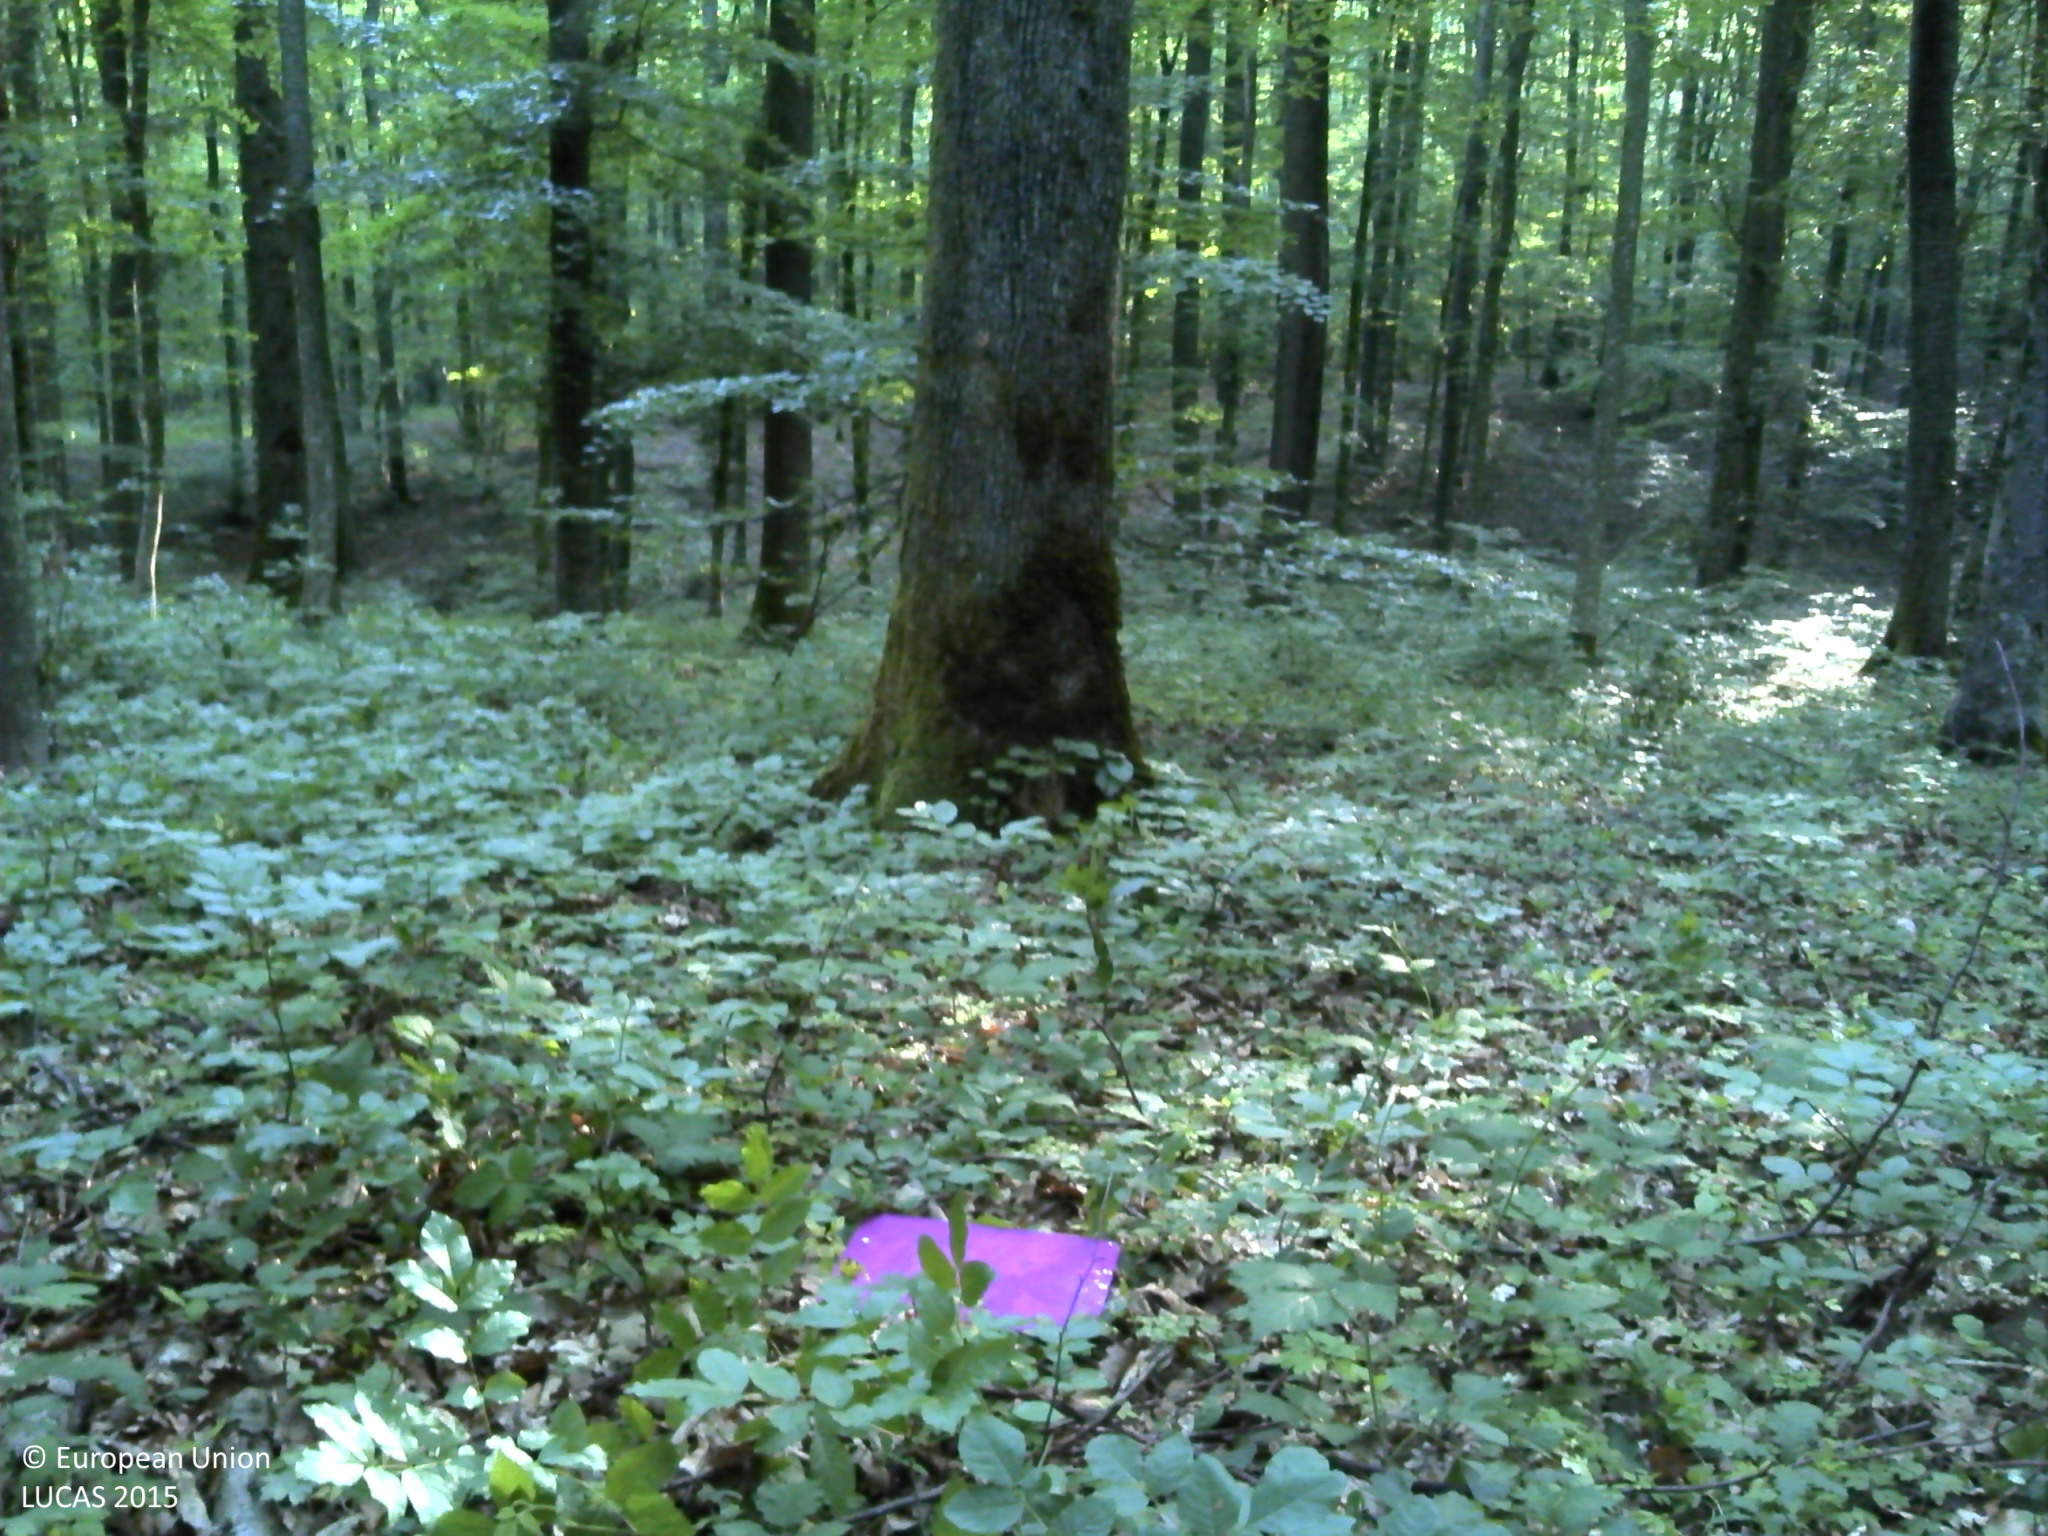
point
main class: Woodland
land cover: Broadleaved woodland
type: acidophilous oak and oak-birch forest
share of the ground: > 75 %
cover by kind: broadleaved forest trees 100 %
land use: Forestry
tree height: > 5 m
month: May
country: HR
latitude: 45.4722
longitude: 17.9982
